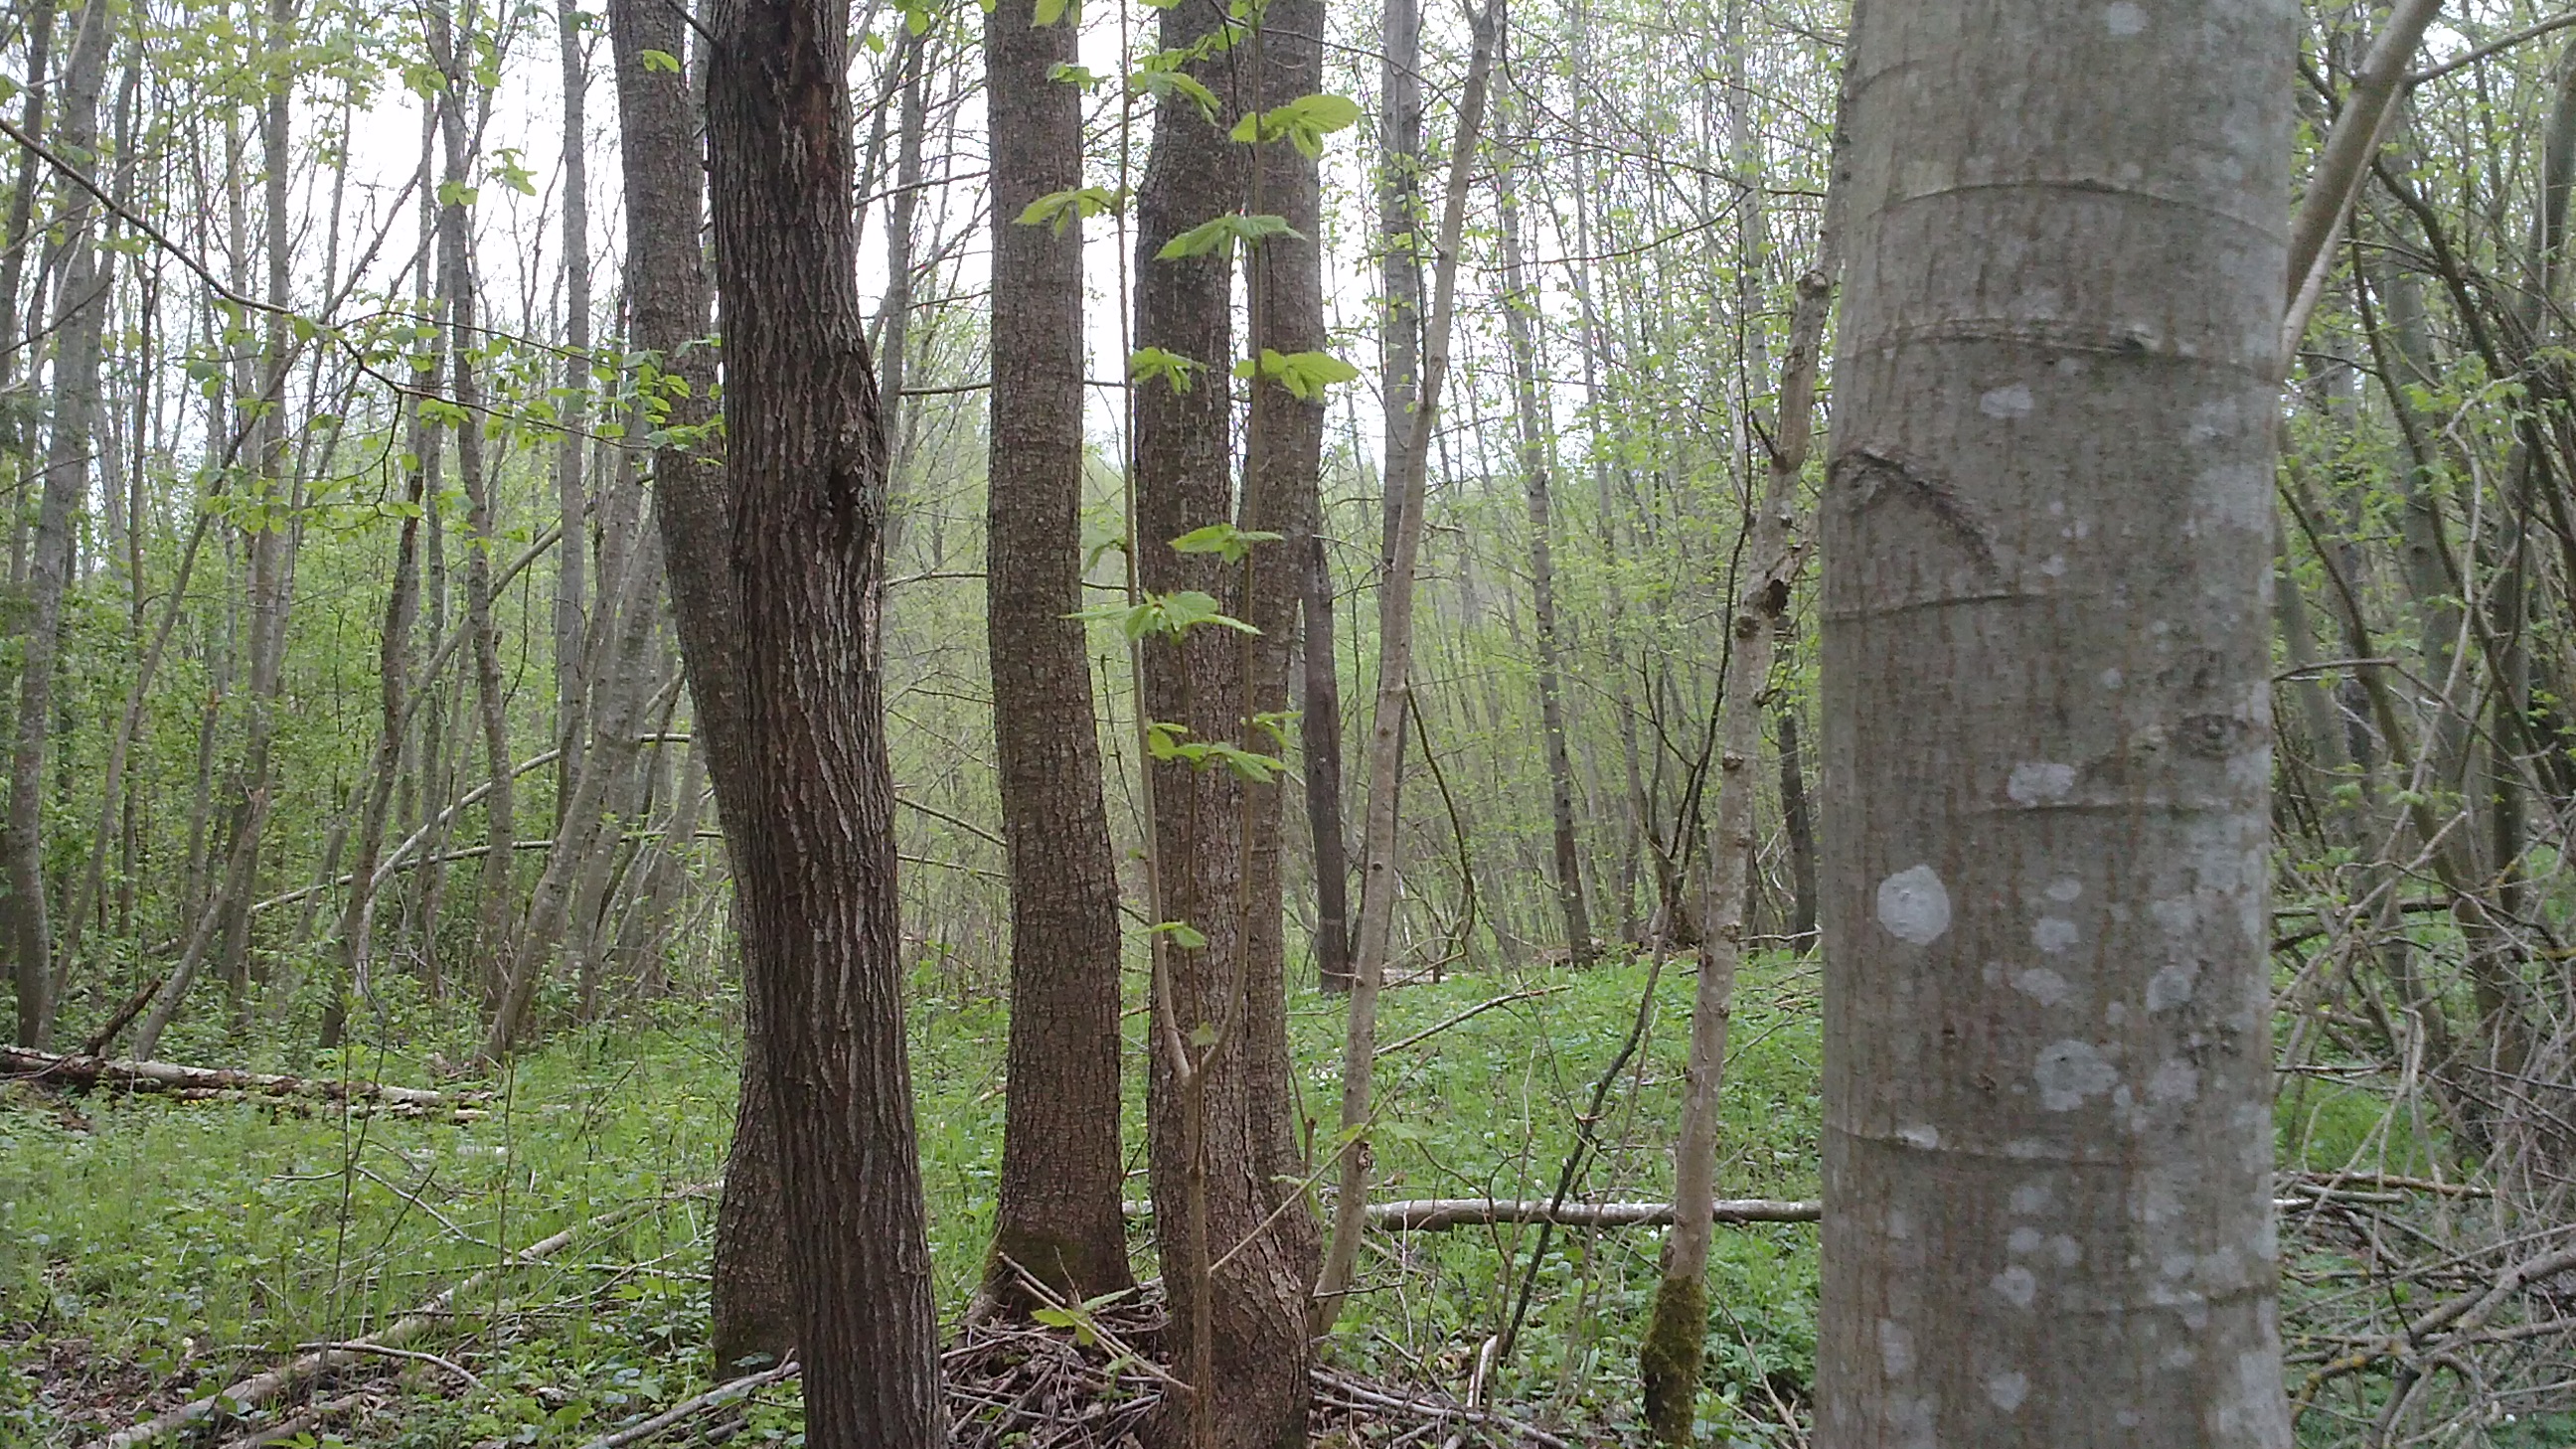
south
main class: Woodland
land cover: Broadleaved woodland
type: non-riverine alder, birch or aspen forest
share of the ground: > 75 %
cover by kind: broadleaved forest trees 90 %, coniferous forest trees 10 %
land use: Forestry
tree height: > 5 m
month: May
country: LV
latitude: 55.9838
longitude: 27.1106
